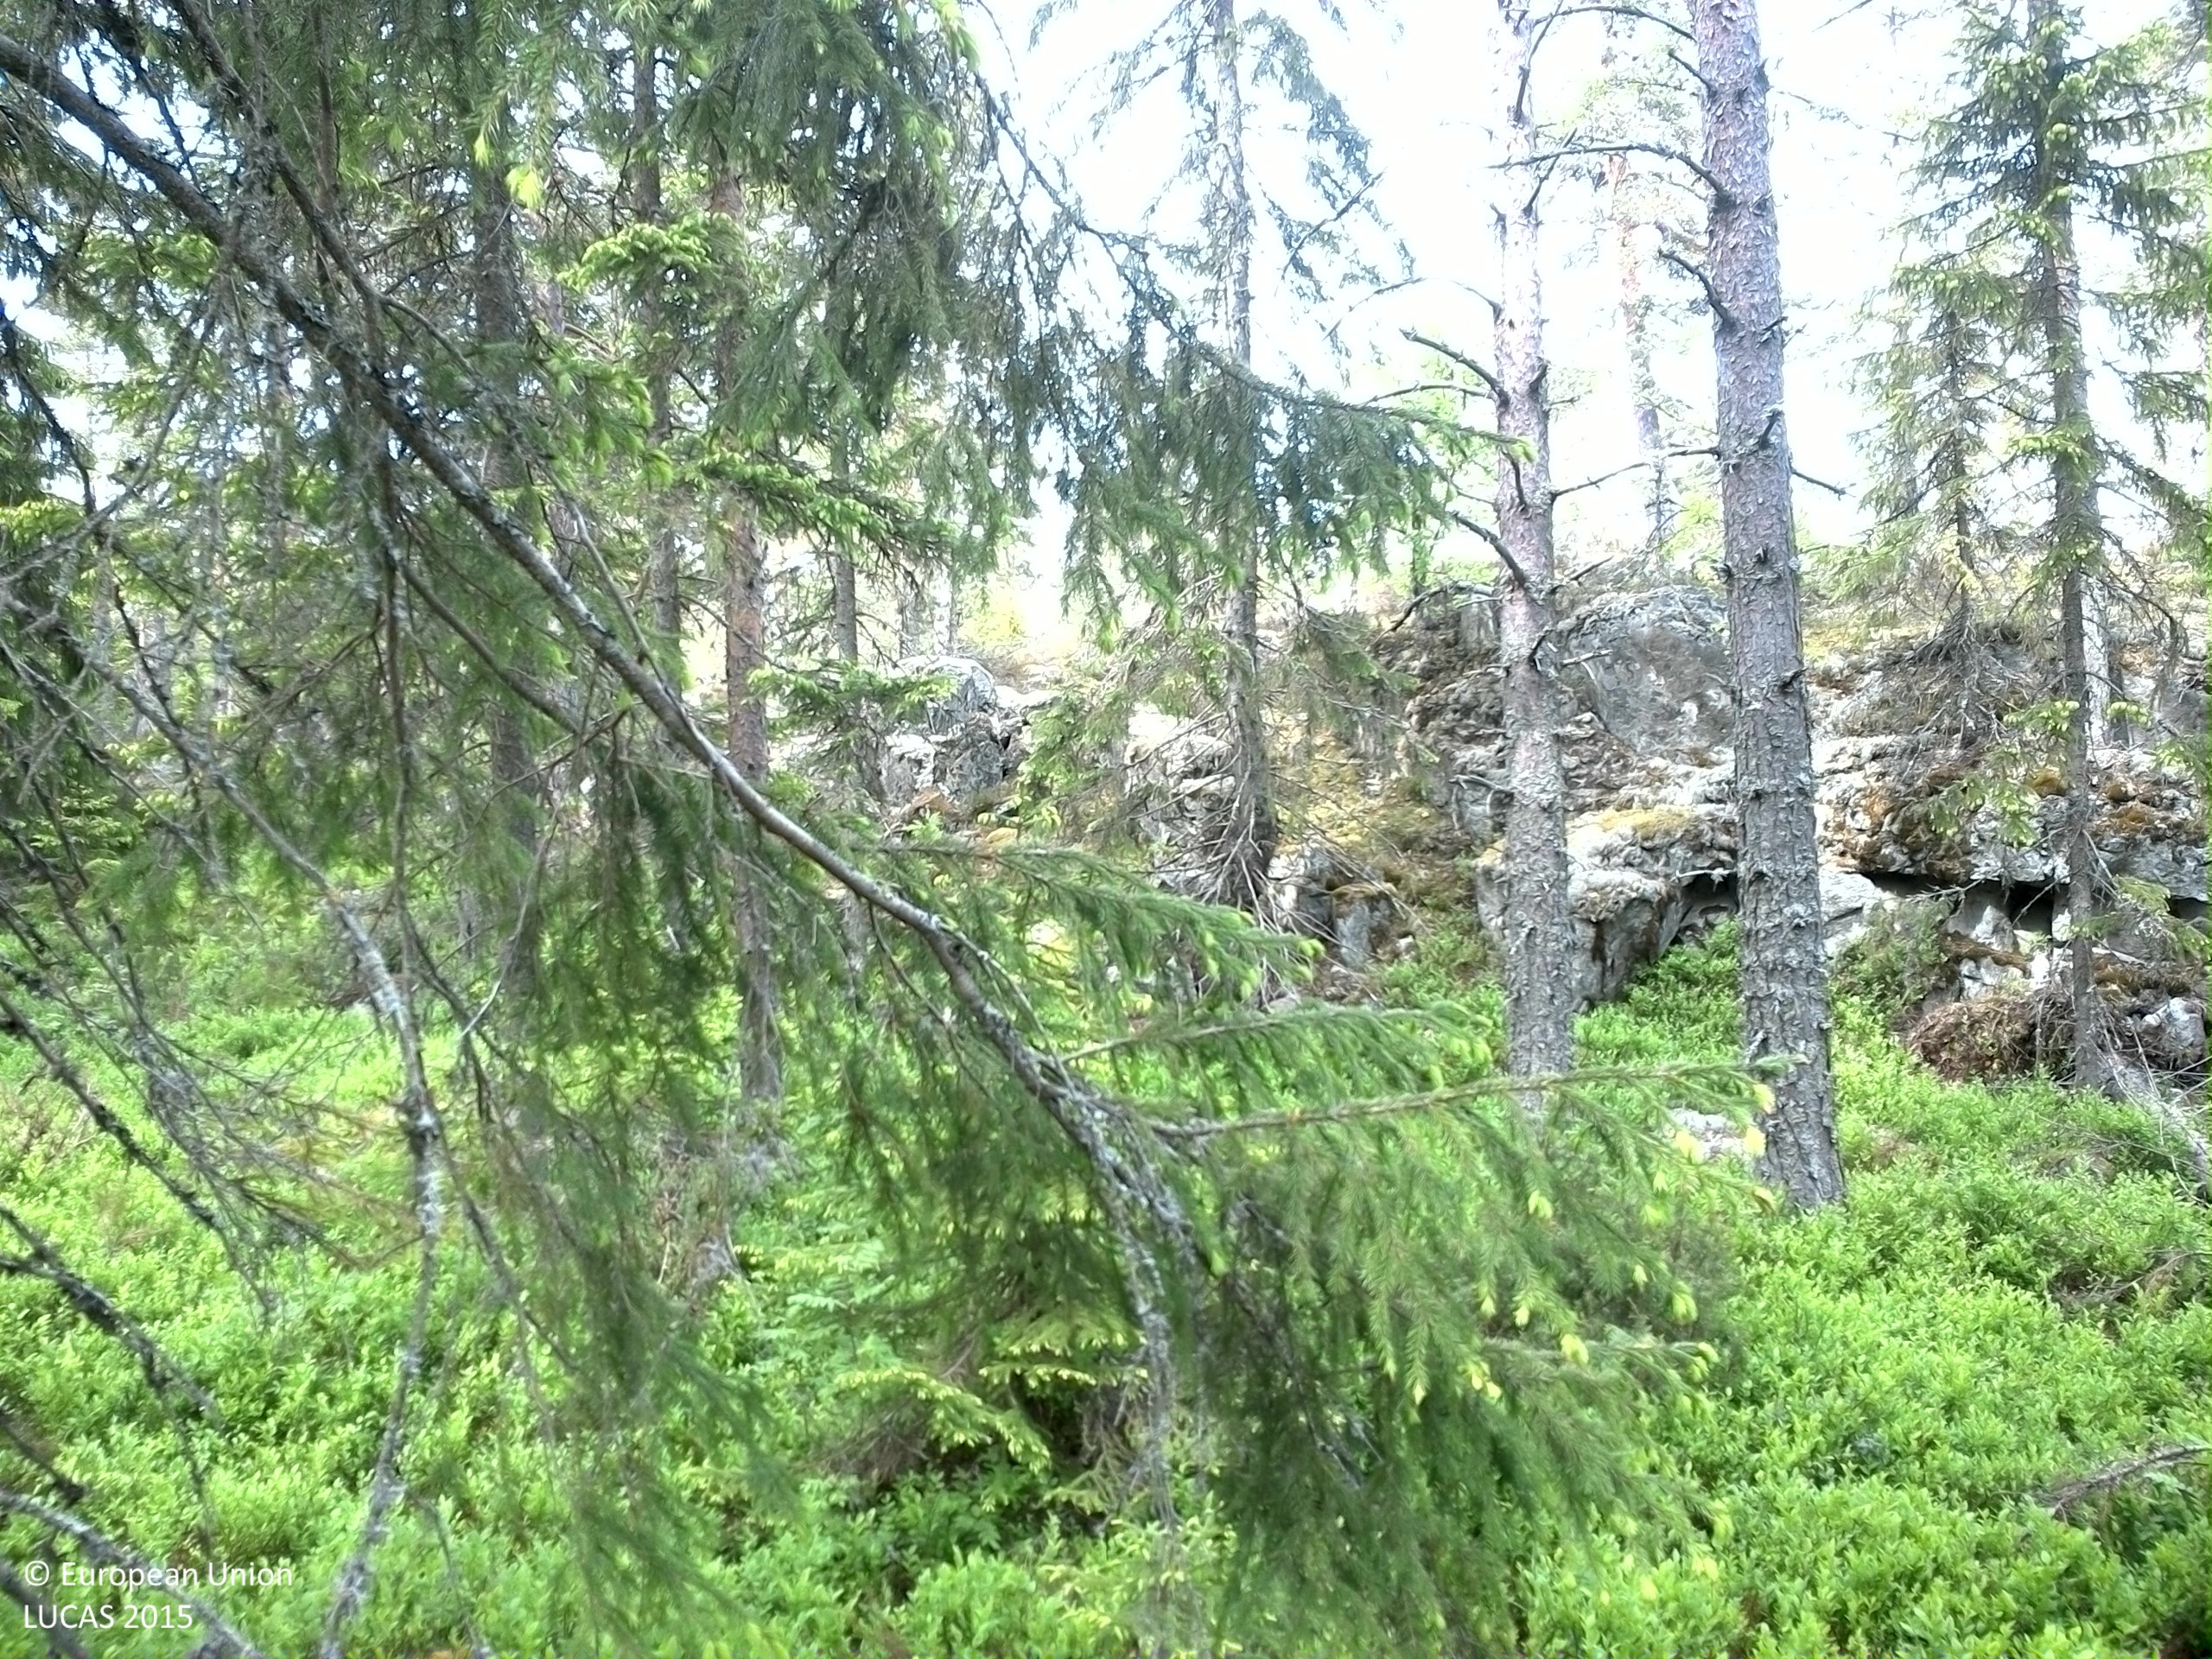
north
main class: Woodland
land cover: Spruce dominated coniferous woodland
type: boreal forest
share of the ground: 50 - 75 %
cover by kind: coniferous forest trees 70 %, shrubs 25 %, broadleaved forest trees 5 %
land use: Forestry
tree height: > 5 m
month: June
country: SE
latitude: 62.7192
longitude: 17.7823
